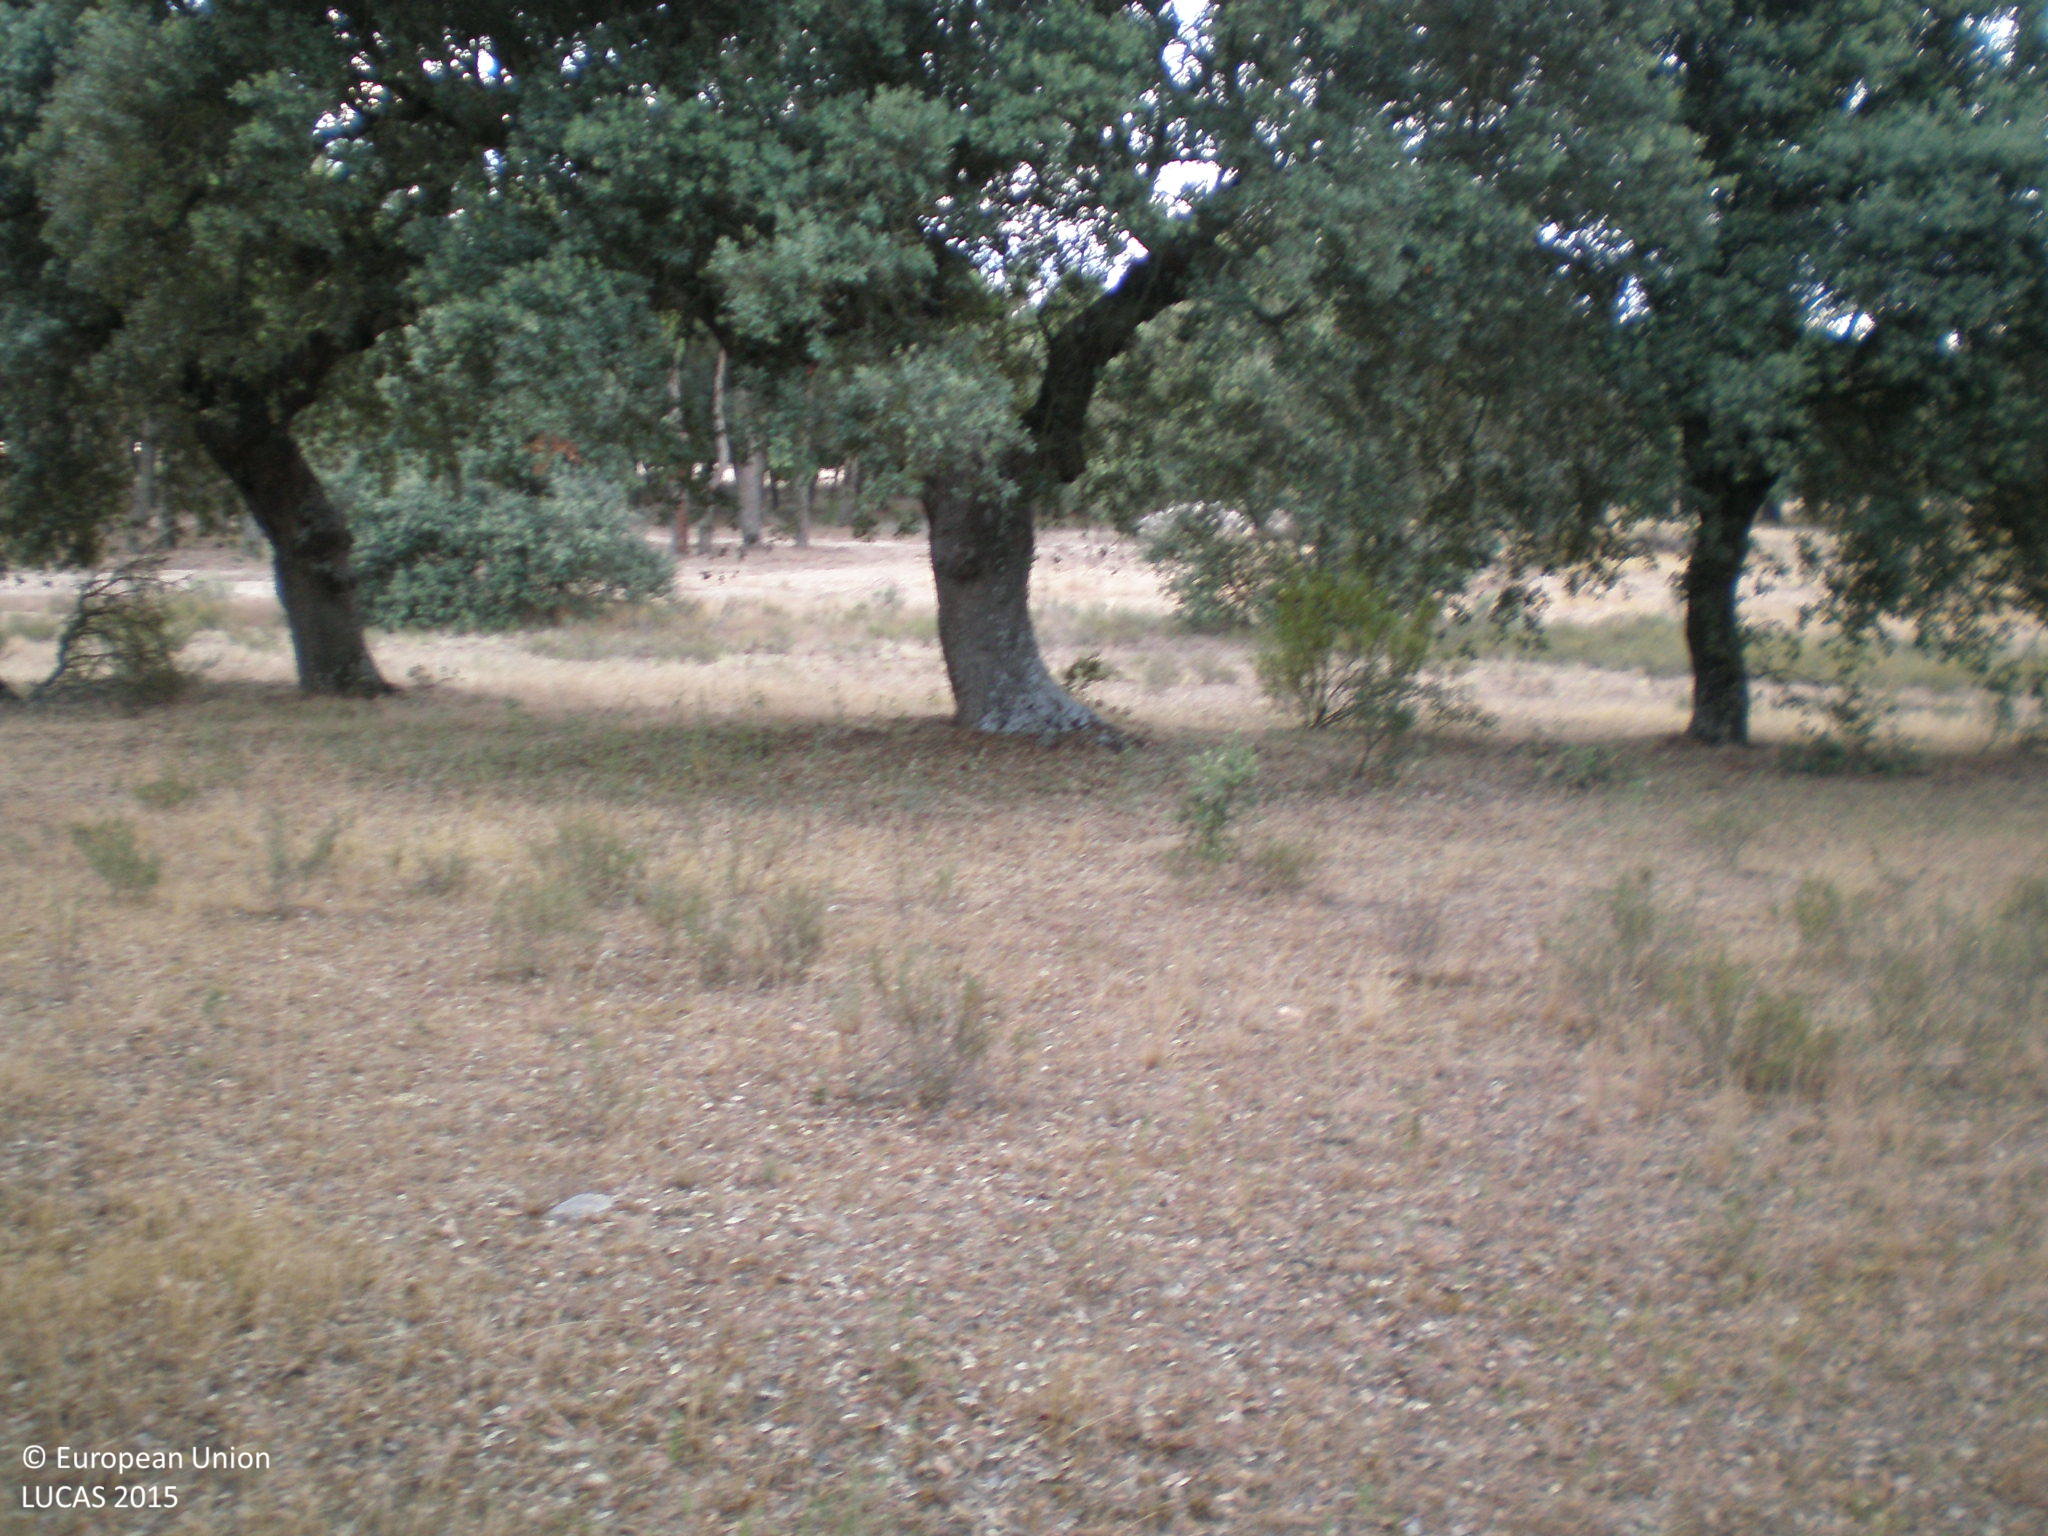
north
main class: Woodland
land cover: Broadleaved woodland
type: broadleaved evergreen forest
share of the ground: 50 - 75 %
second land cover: Grassland without tree/shrub cover
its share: 25 - 50 %
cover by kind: broadleaved forest trees 60 %, herbaceous plants 40 %
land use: Forestry
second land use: Agriculture (excluding fallow land and kitchen gardens)
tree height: > 5 m
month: June
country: ES
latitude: 41.1301
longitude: -5.7941
